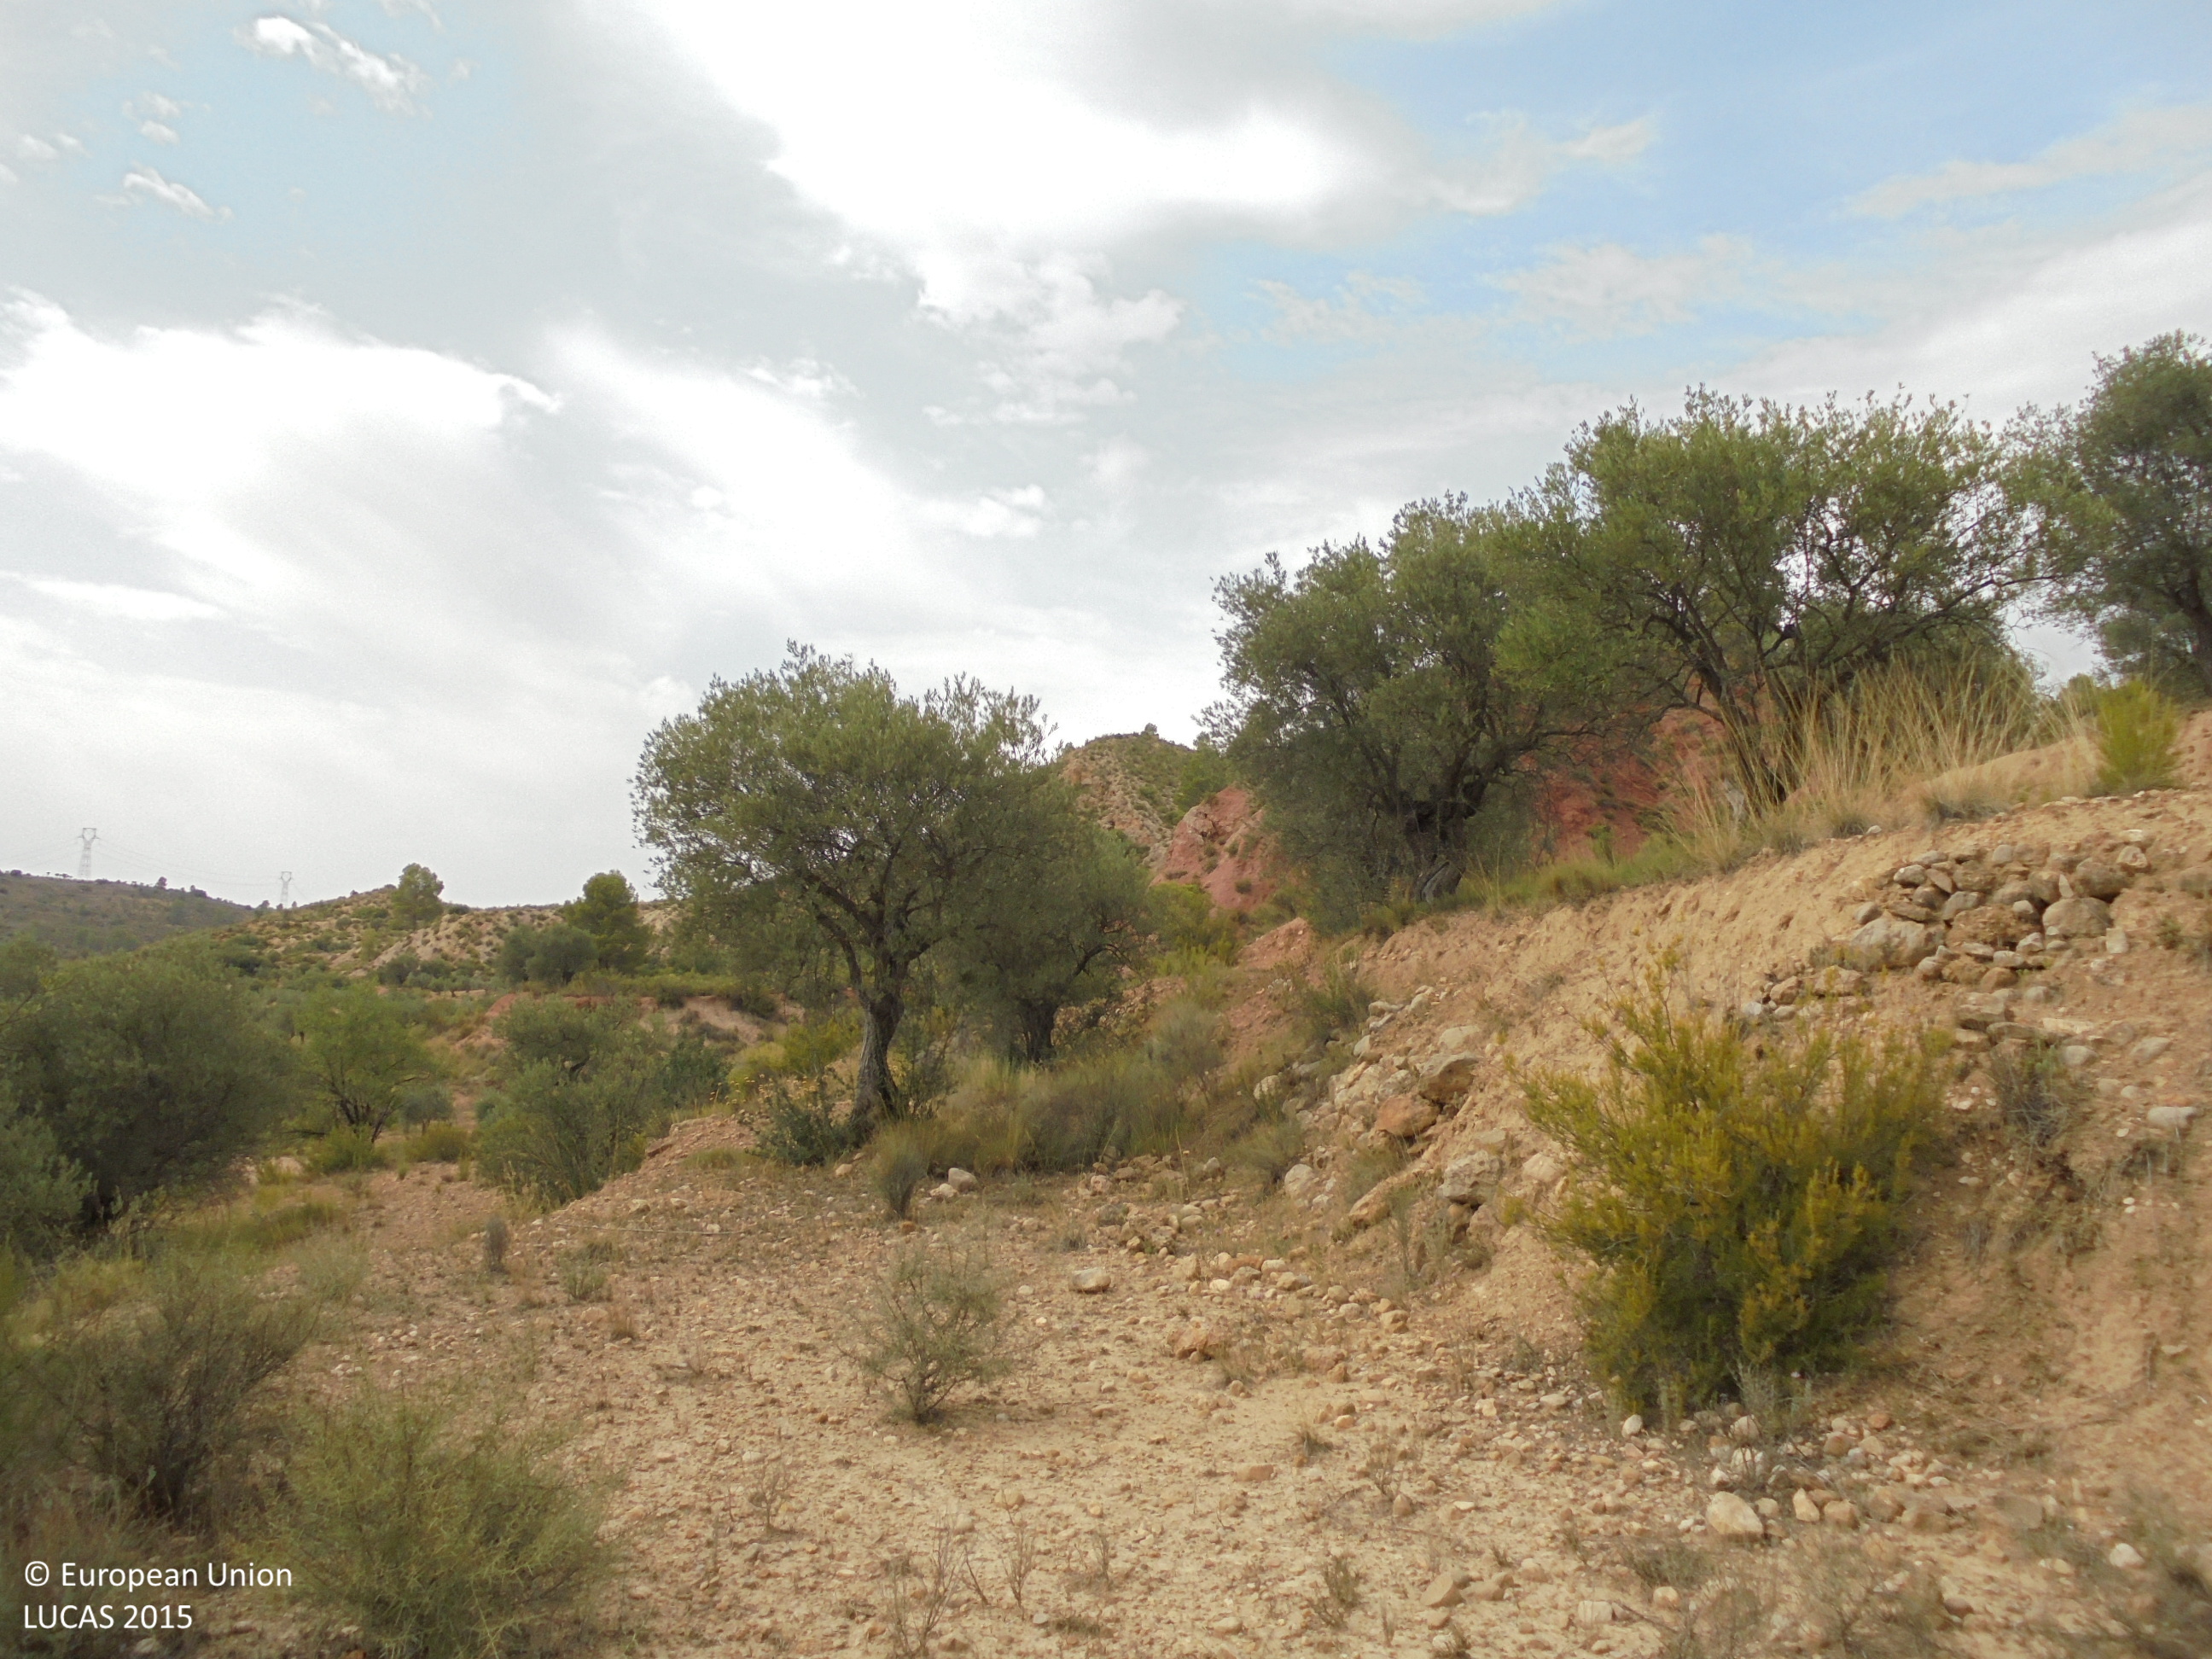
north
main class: Cropland
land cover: Olive groves
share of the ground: 25 - 50 %
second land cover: Shrubland without tree cover
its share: 25 - 50 %
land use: Abandoned areas
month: August
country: ES
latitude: 39.1486
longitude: -1.0474
